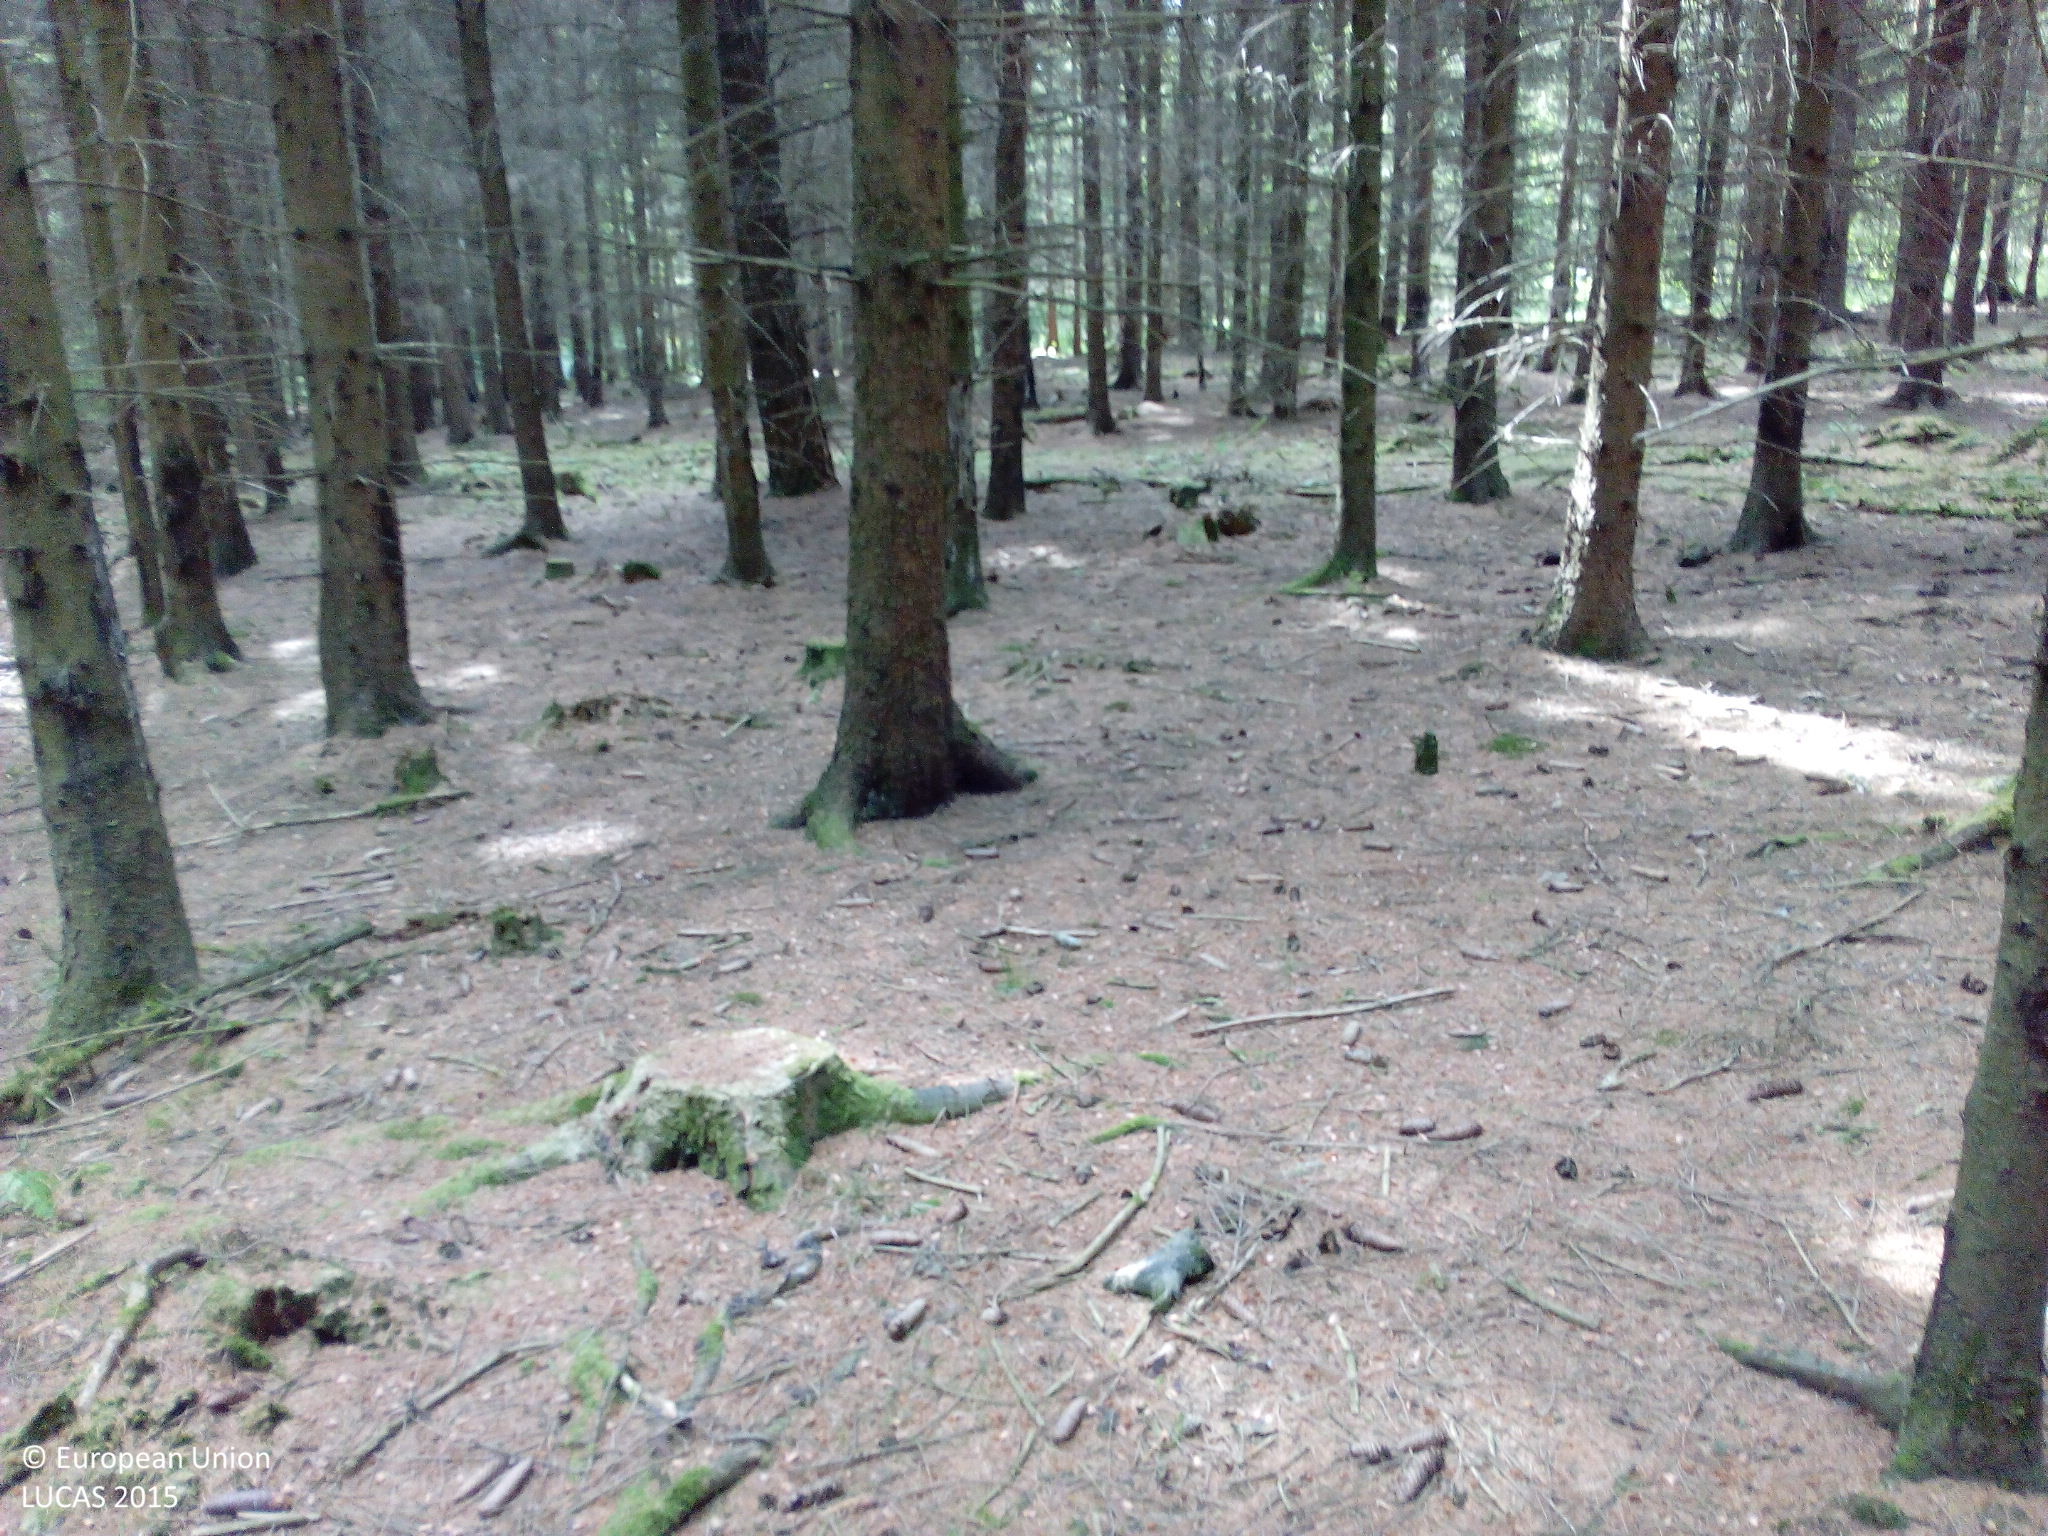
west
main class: Woodland
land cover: Spruce dominated coniferous woodland
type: hemiboreal forest and nemoral coniferous forest and mixed broadleaved-coniferous forest
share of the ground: > 75 %
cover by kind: coniferous forest trees 100 %
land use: Forestry
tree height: > 5 m
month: July
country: DE
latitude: 49.6624
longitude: 7.1325
